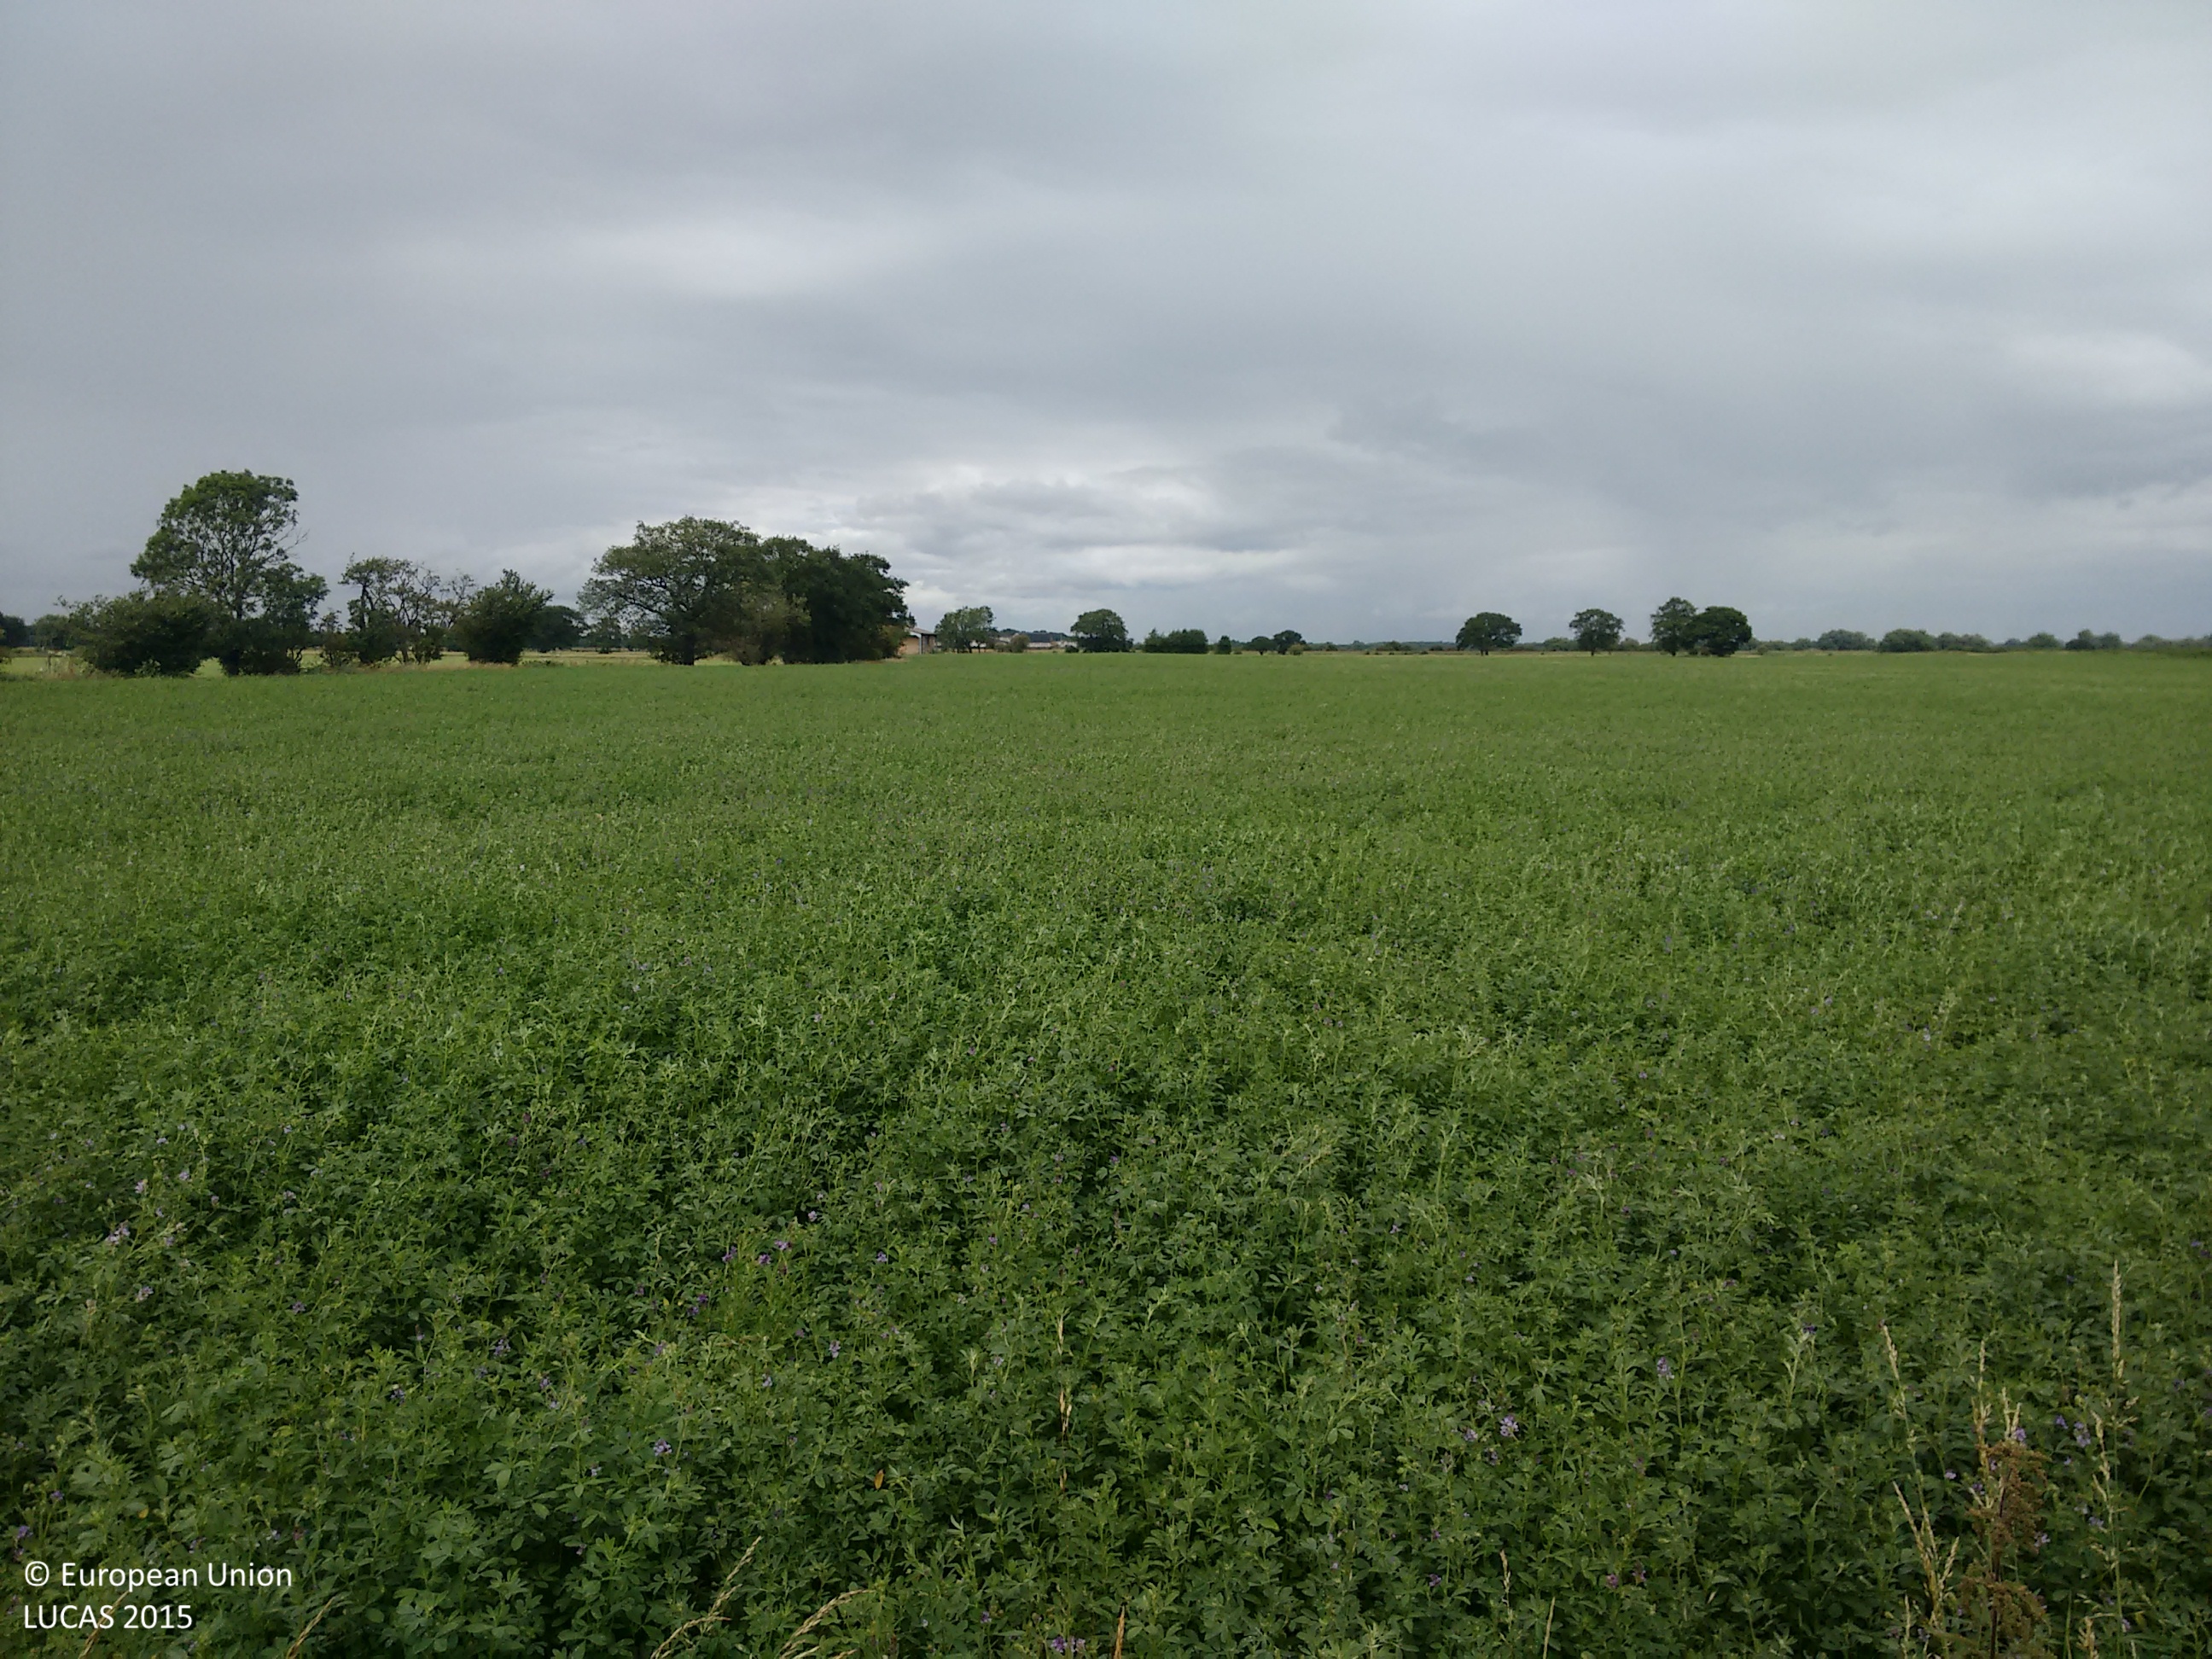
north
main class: Cropland
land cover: Other fibre and oleaginous crops
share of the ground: > 75 %
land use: Agriculture (excluding fallow land and kitchen gardens)
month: July
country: GB
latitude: 53.4270
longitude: -0.9843
